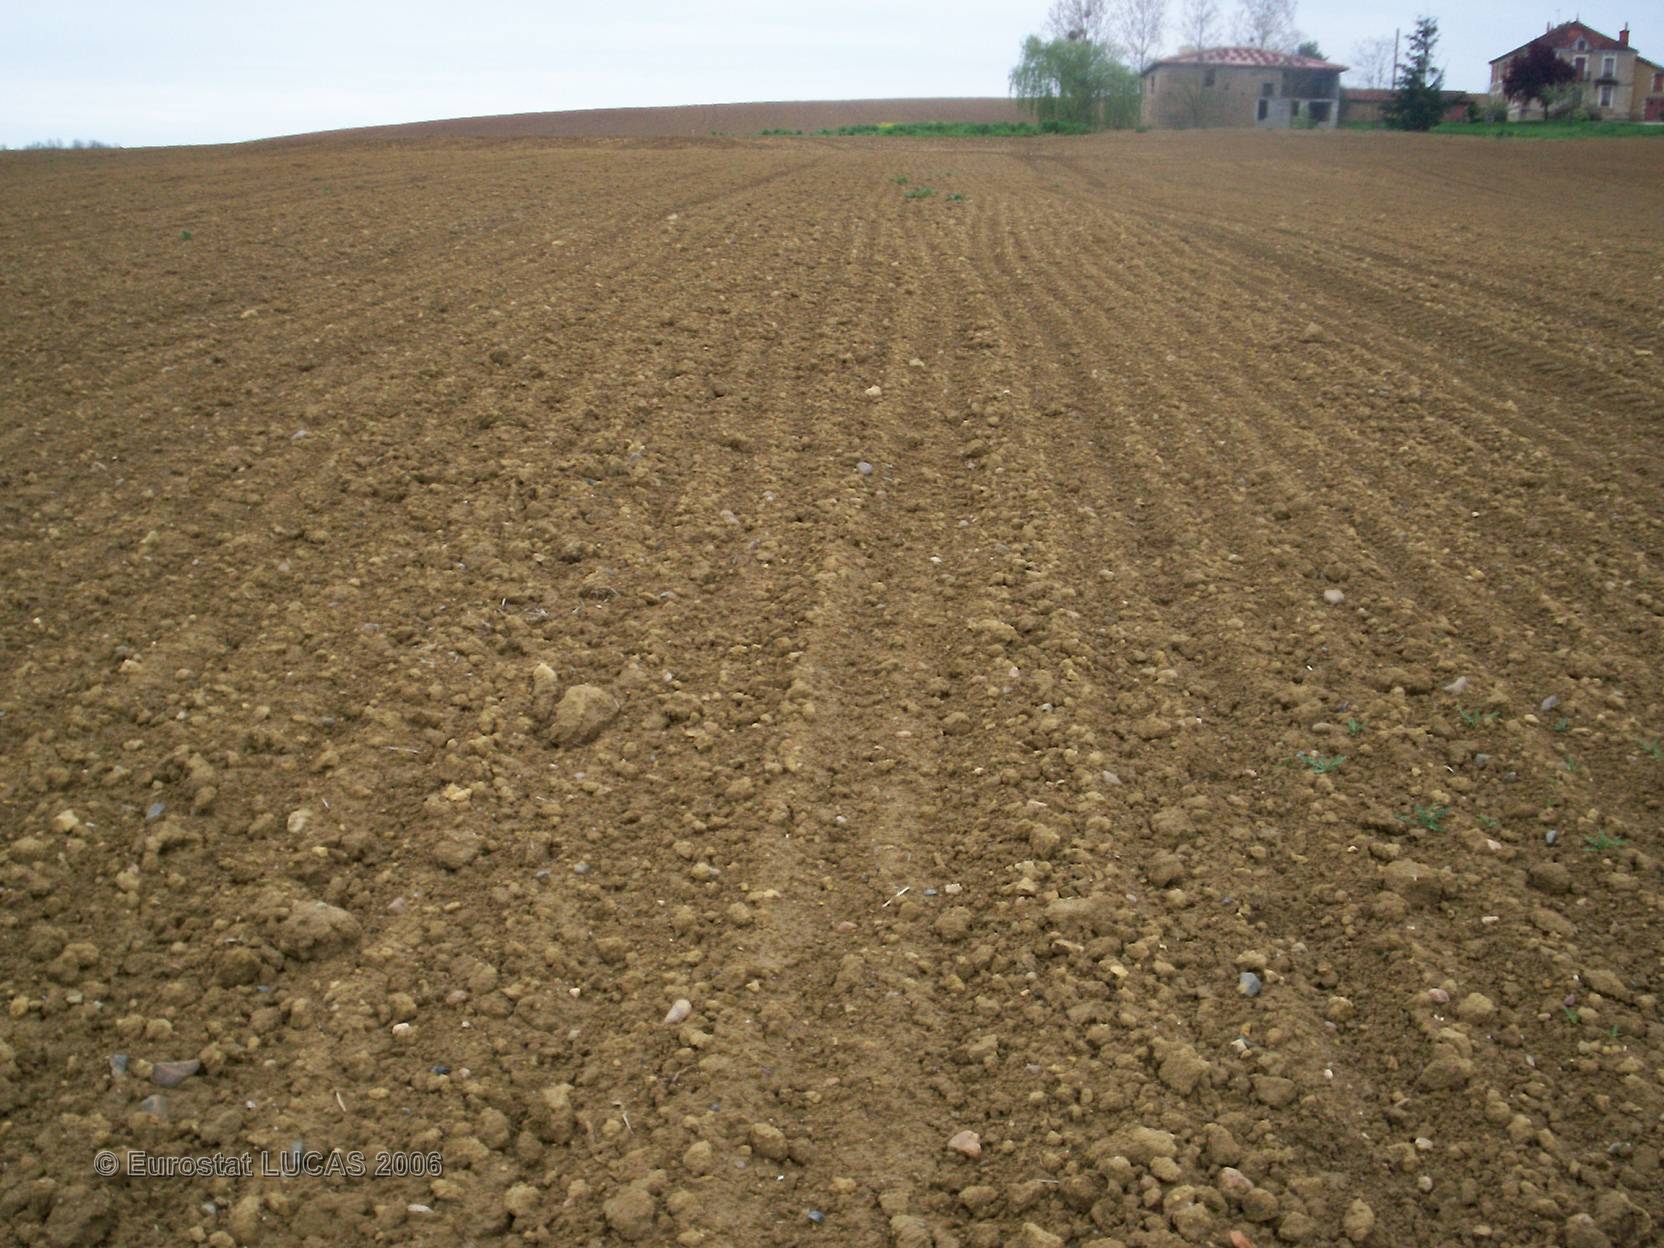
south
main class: Cropland
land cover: Maize
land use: Agriculture (excluding fallow land and kitchen gardens)
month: June
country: FR
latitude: 43.5684
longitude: 0.3016
